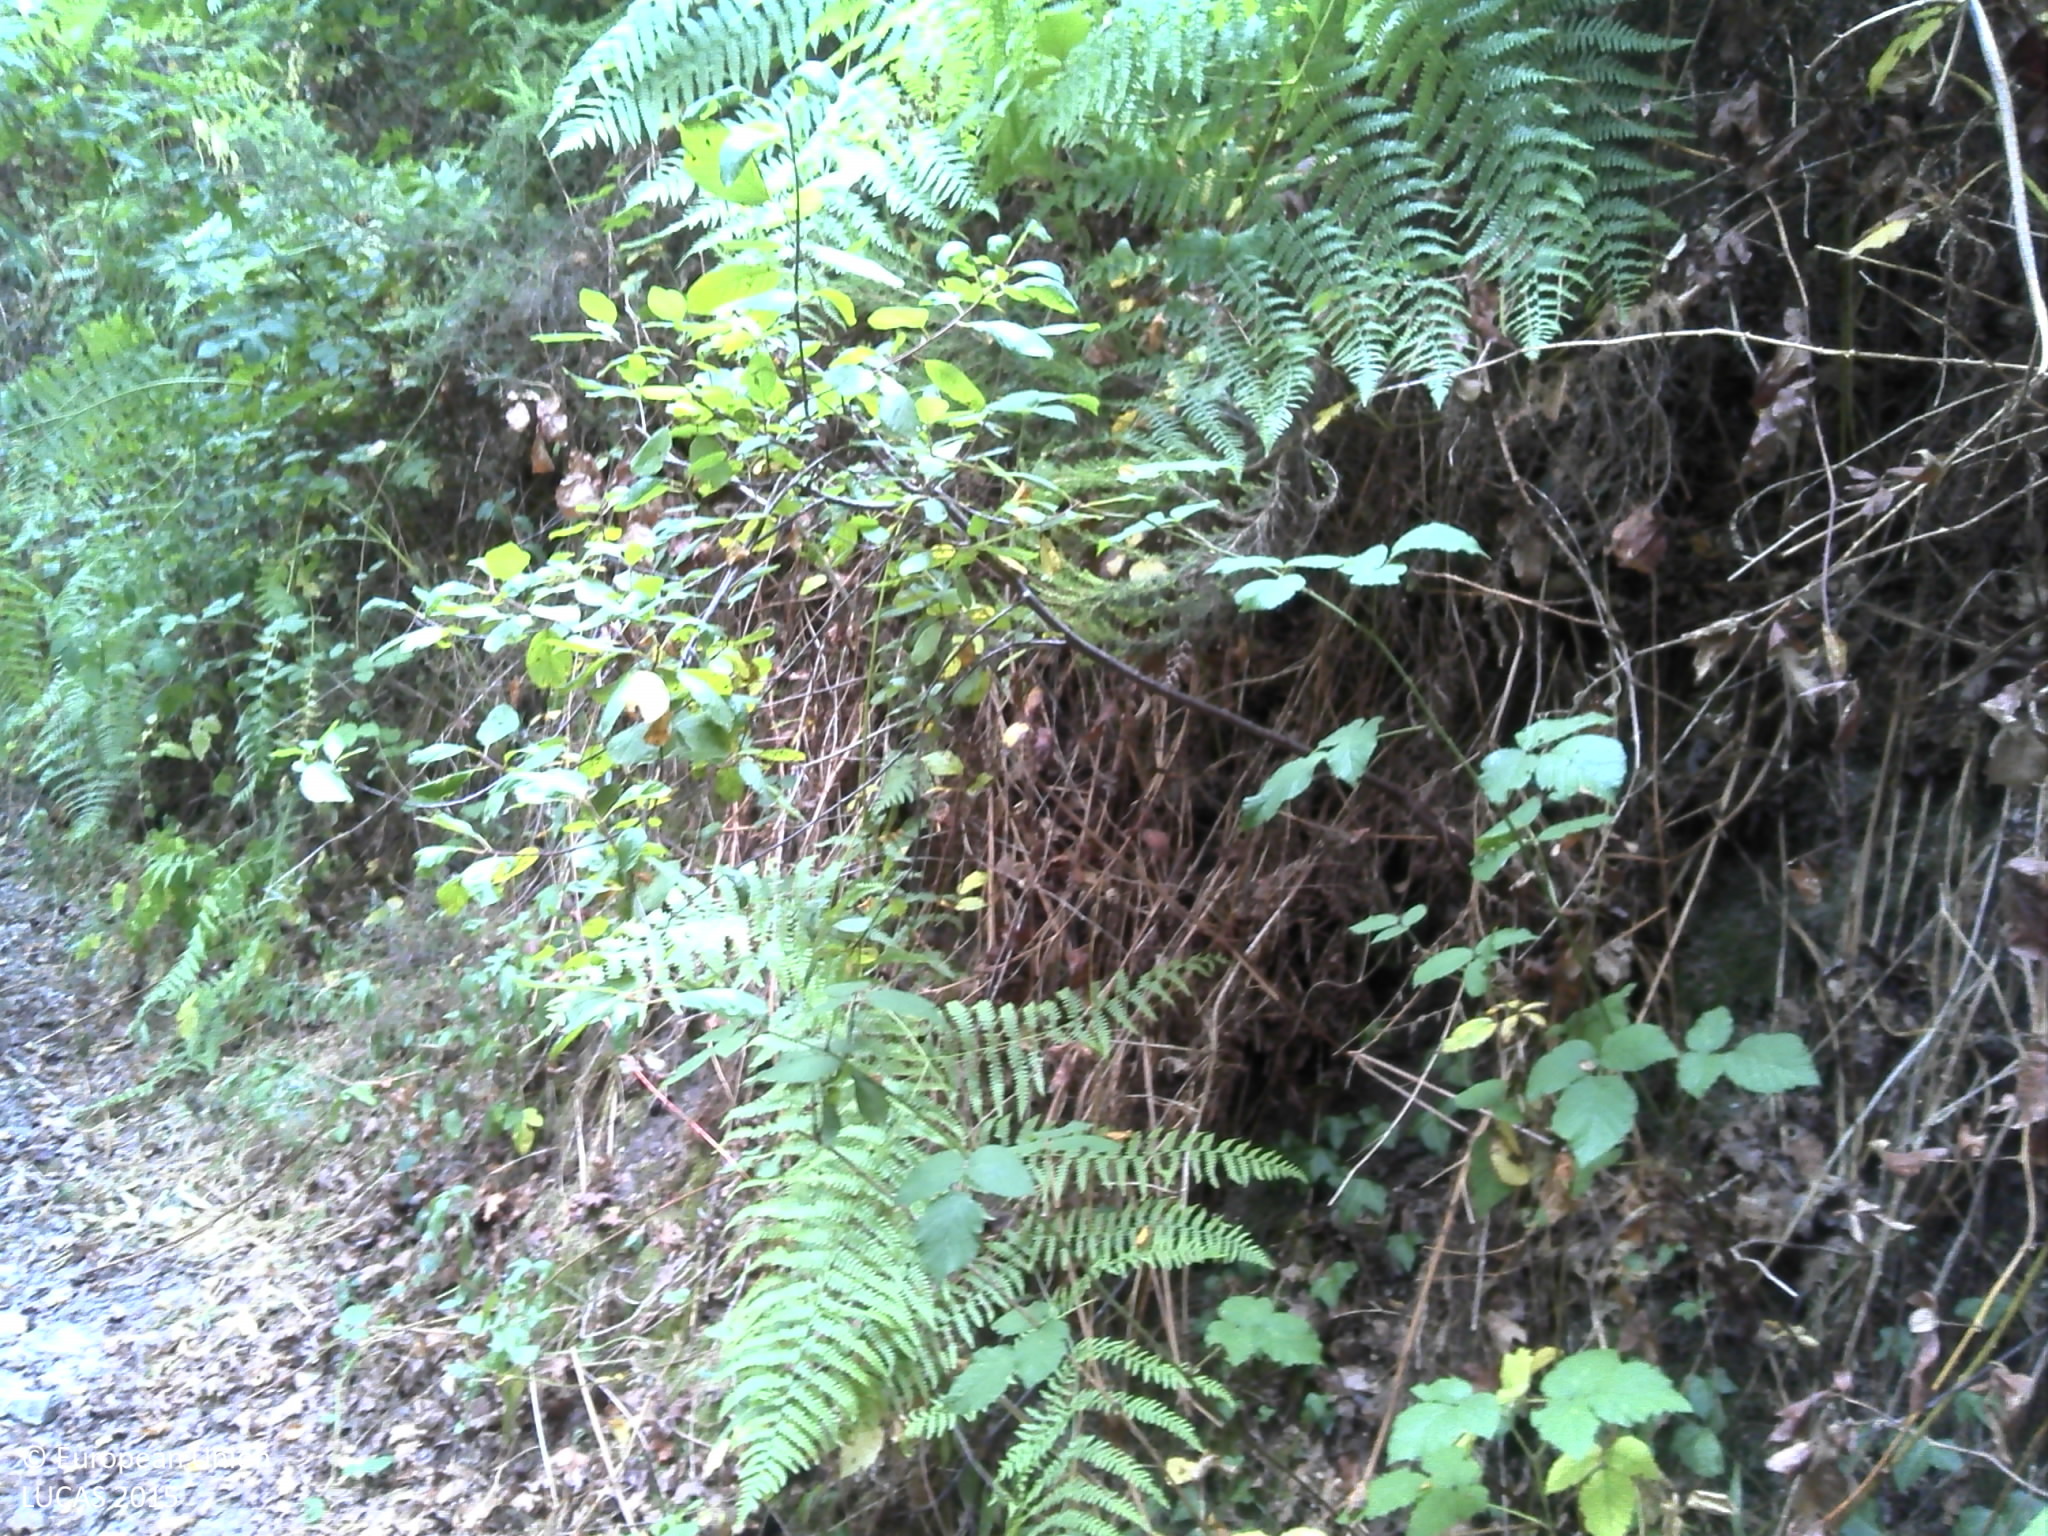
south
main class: Woodland
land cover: Broadleaved woodland
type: thermophilous deciduous forest
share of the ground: > 75 %
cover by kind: broadleaved forest trees 75 %, shrubs 15 %, consolidated bare surface 5 %, unconsolidated bare surface 5 %
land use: Semi-natural and natural areas not in use
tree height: > 5 m
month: July
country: PT
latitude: 41.5445
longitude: -8.0896
